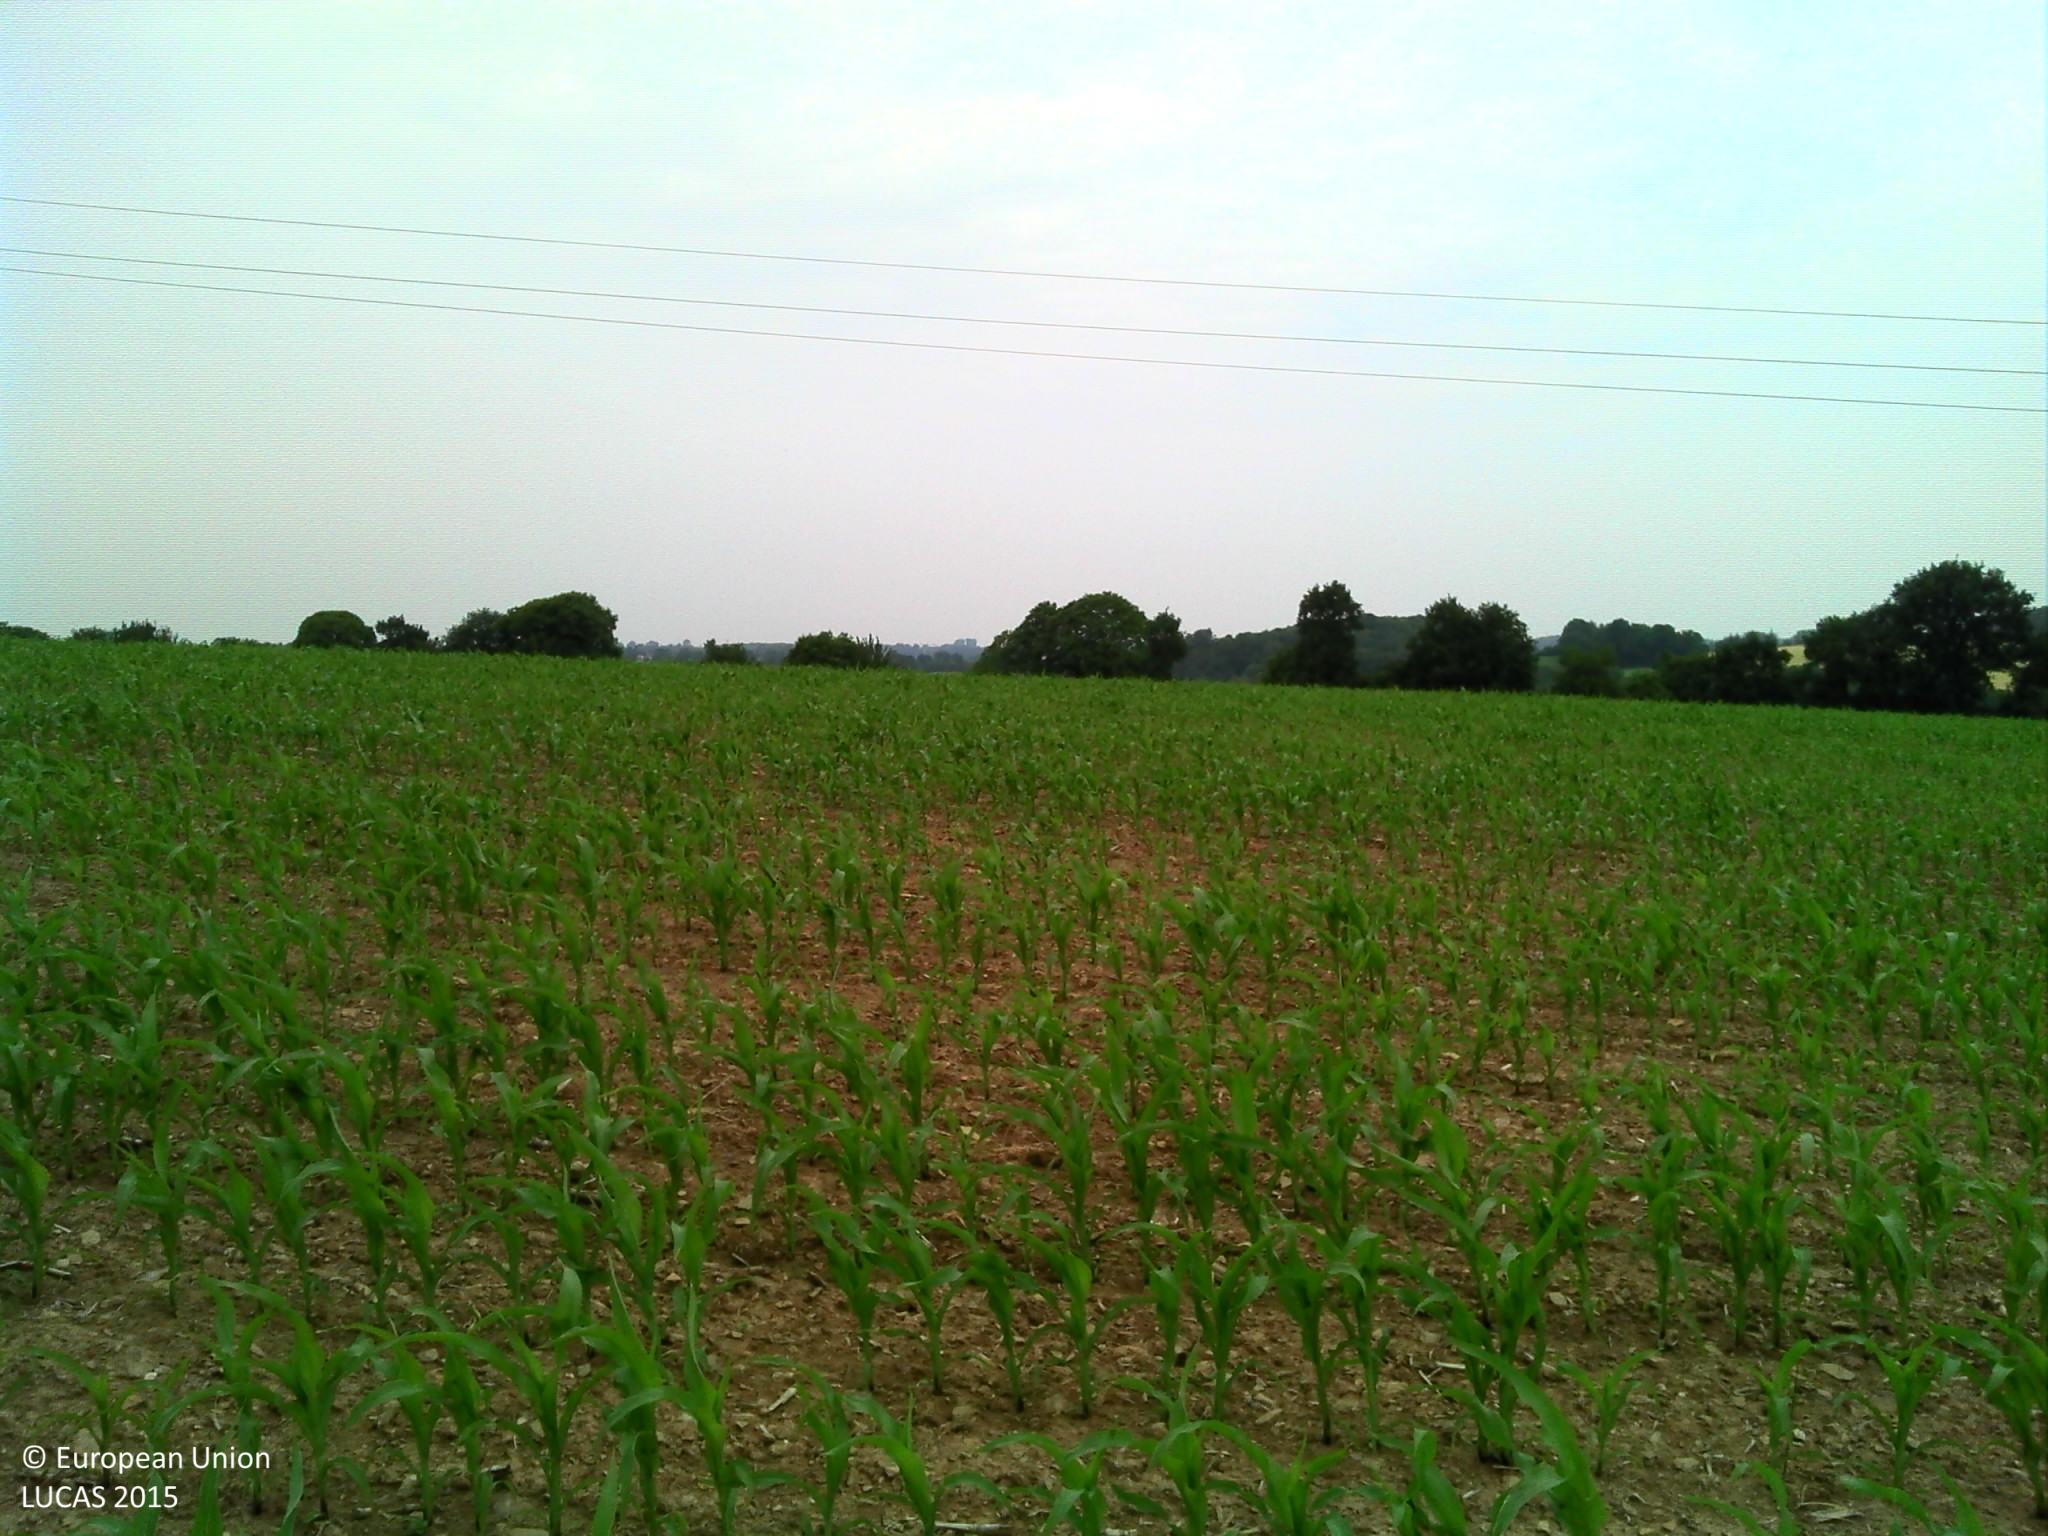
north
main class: Cropland
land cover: Maize
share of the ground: > 75 %
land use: Agriculture (excluding fallow land and kitchen gardens)
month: June
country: FR
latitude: 48.1207
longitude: -2.0770
